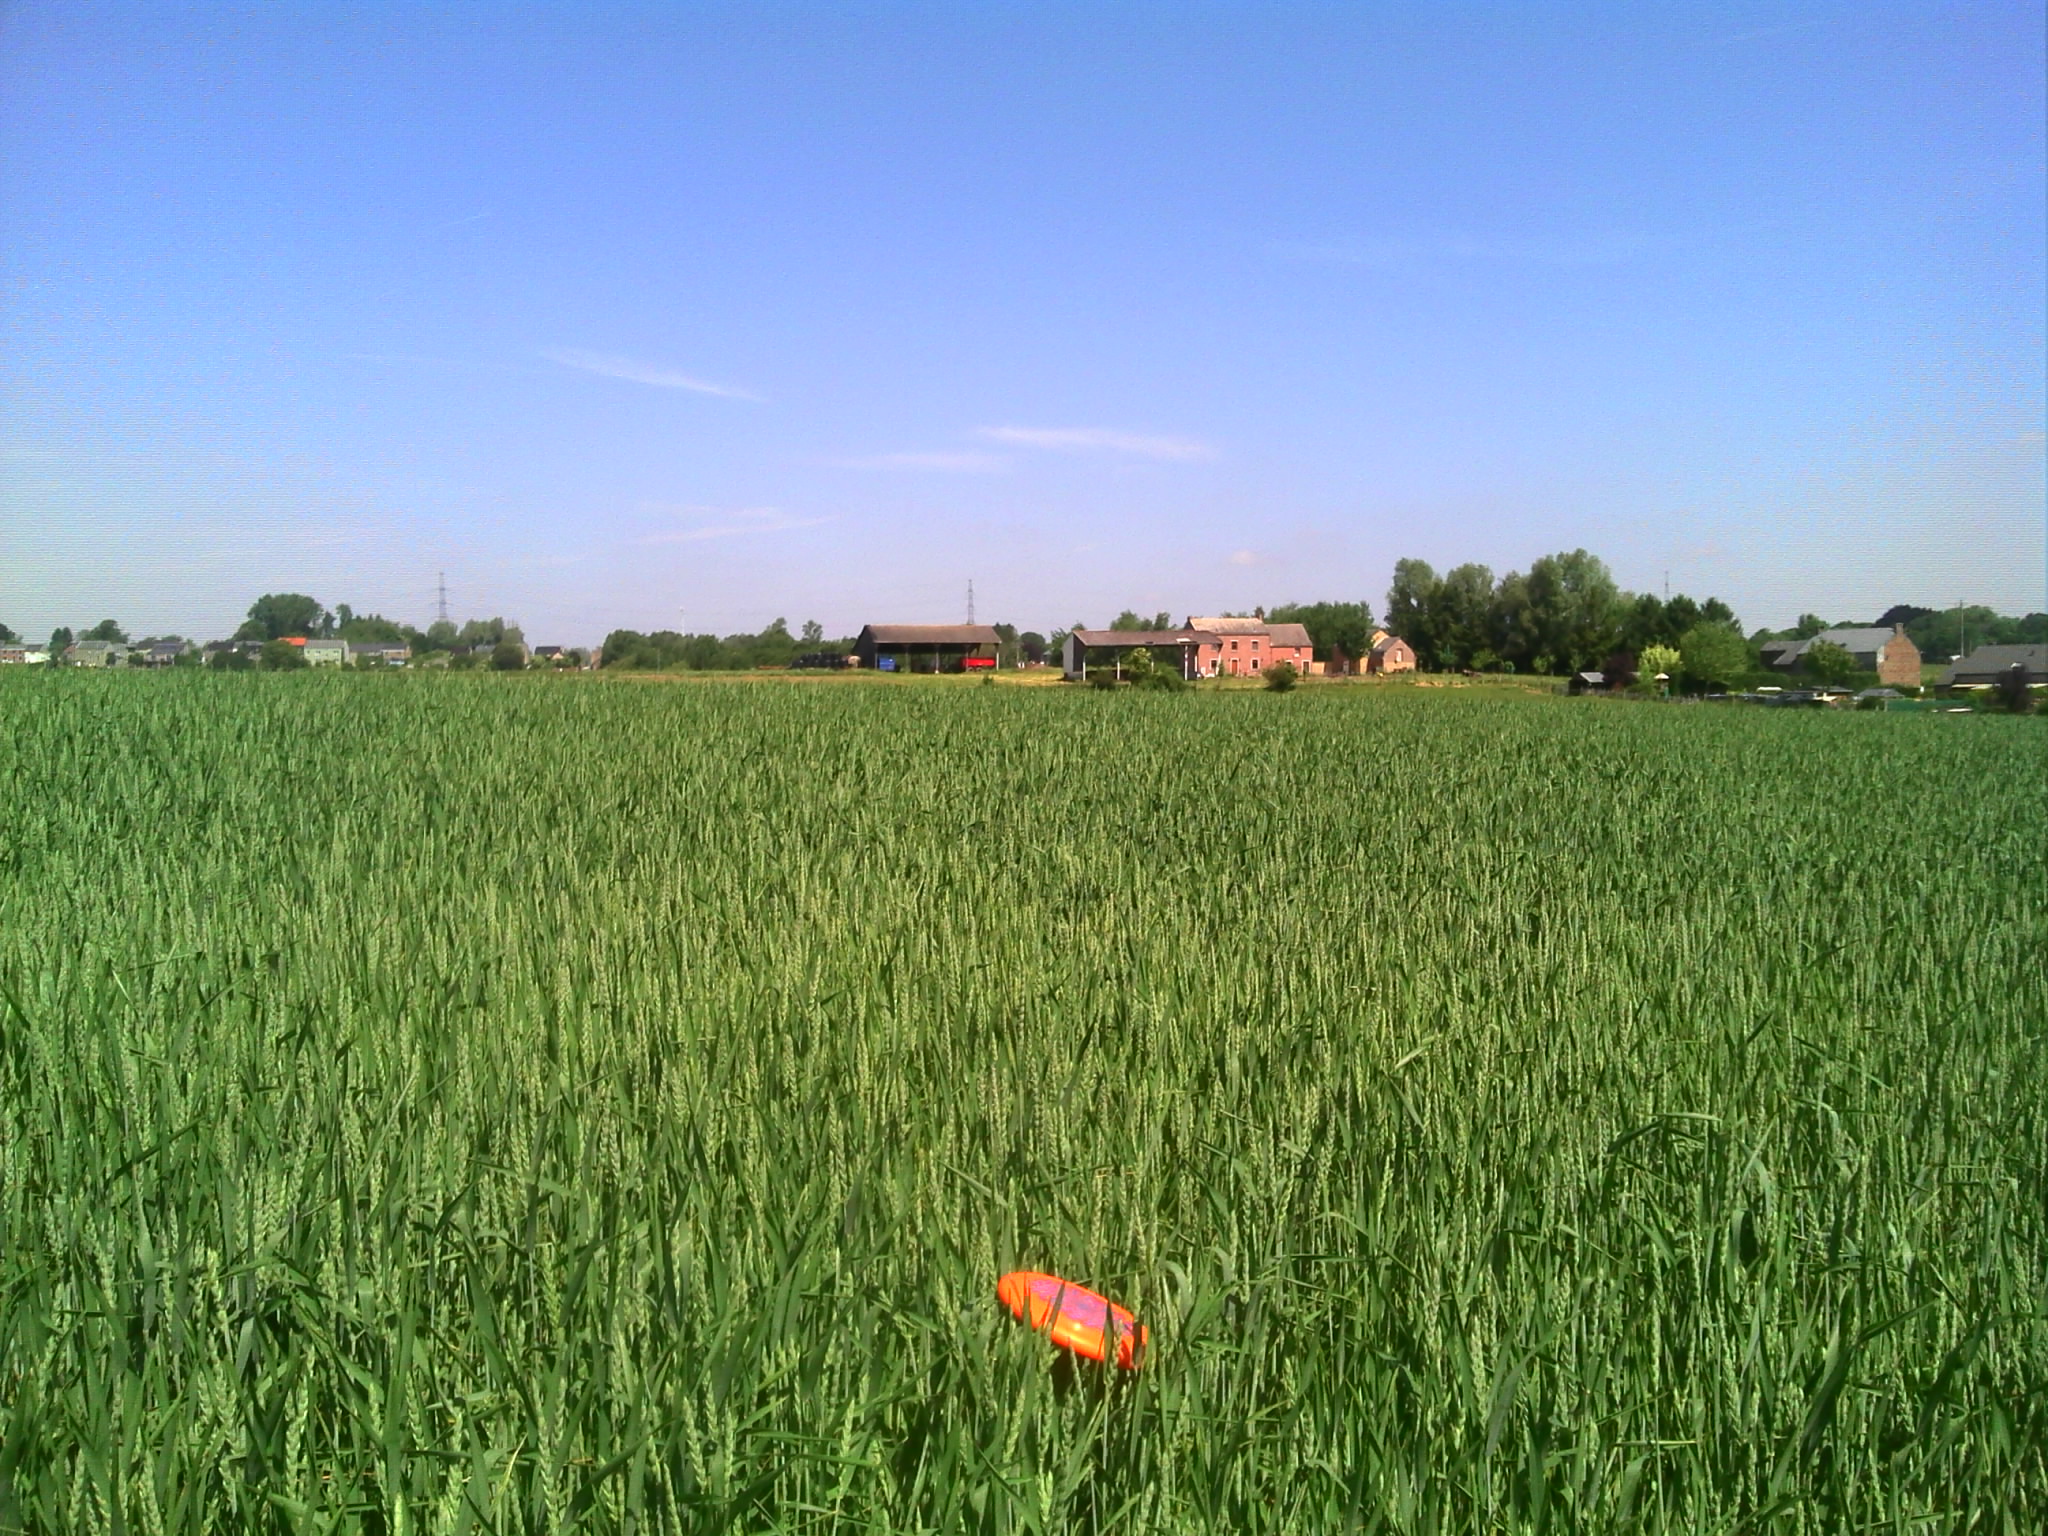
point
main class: Cropland
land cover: Common wheat
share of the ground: > 75 %
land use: Agriculture (excluding fallow land and kitchen gardens)
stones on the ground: < 10 %
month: June
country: BE
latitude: 50.4978
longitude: 4.7946
